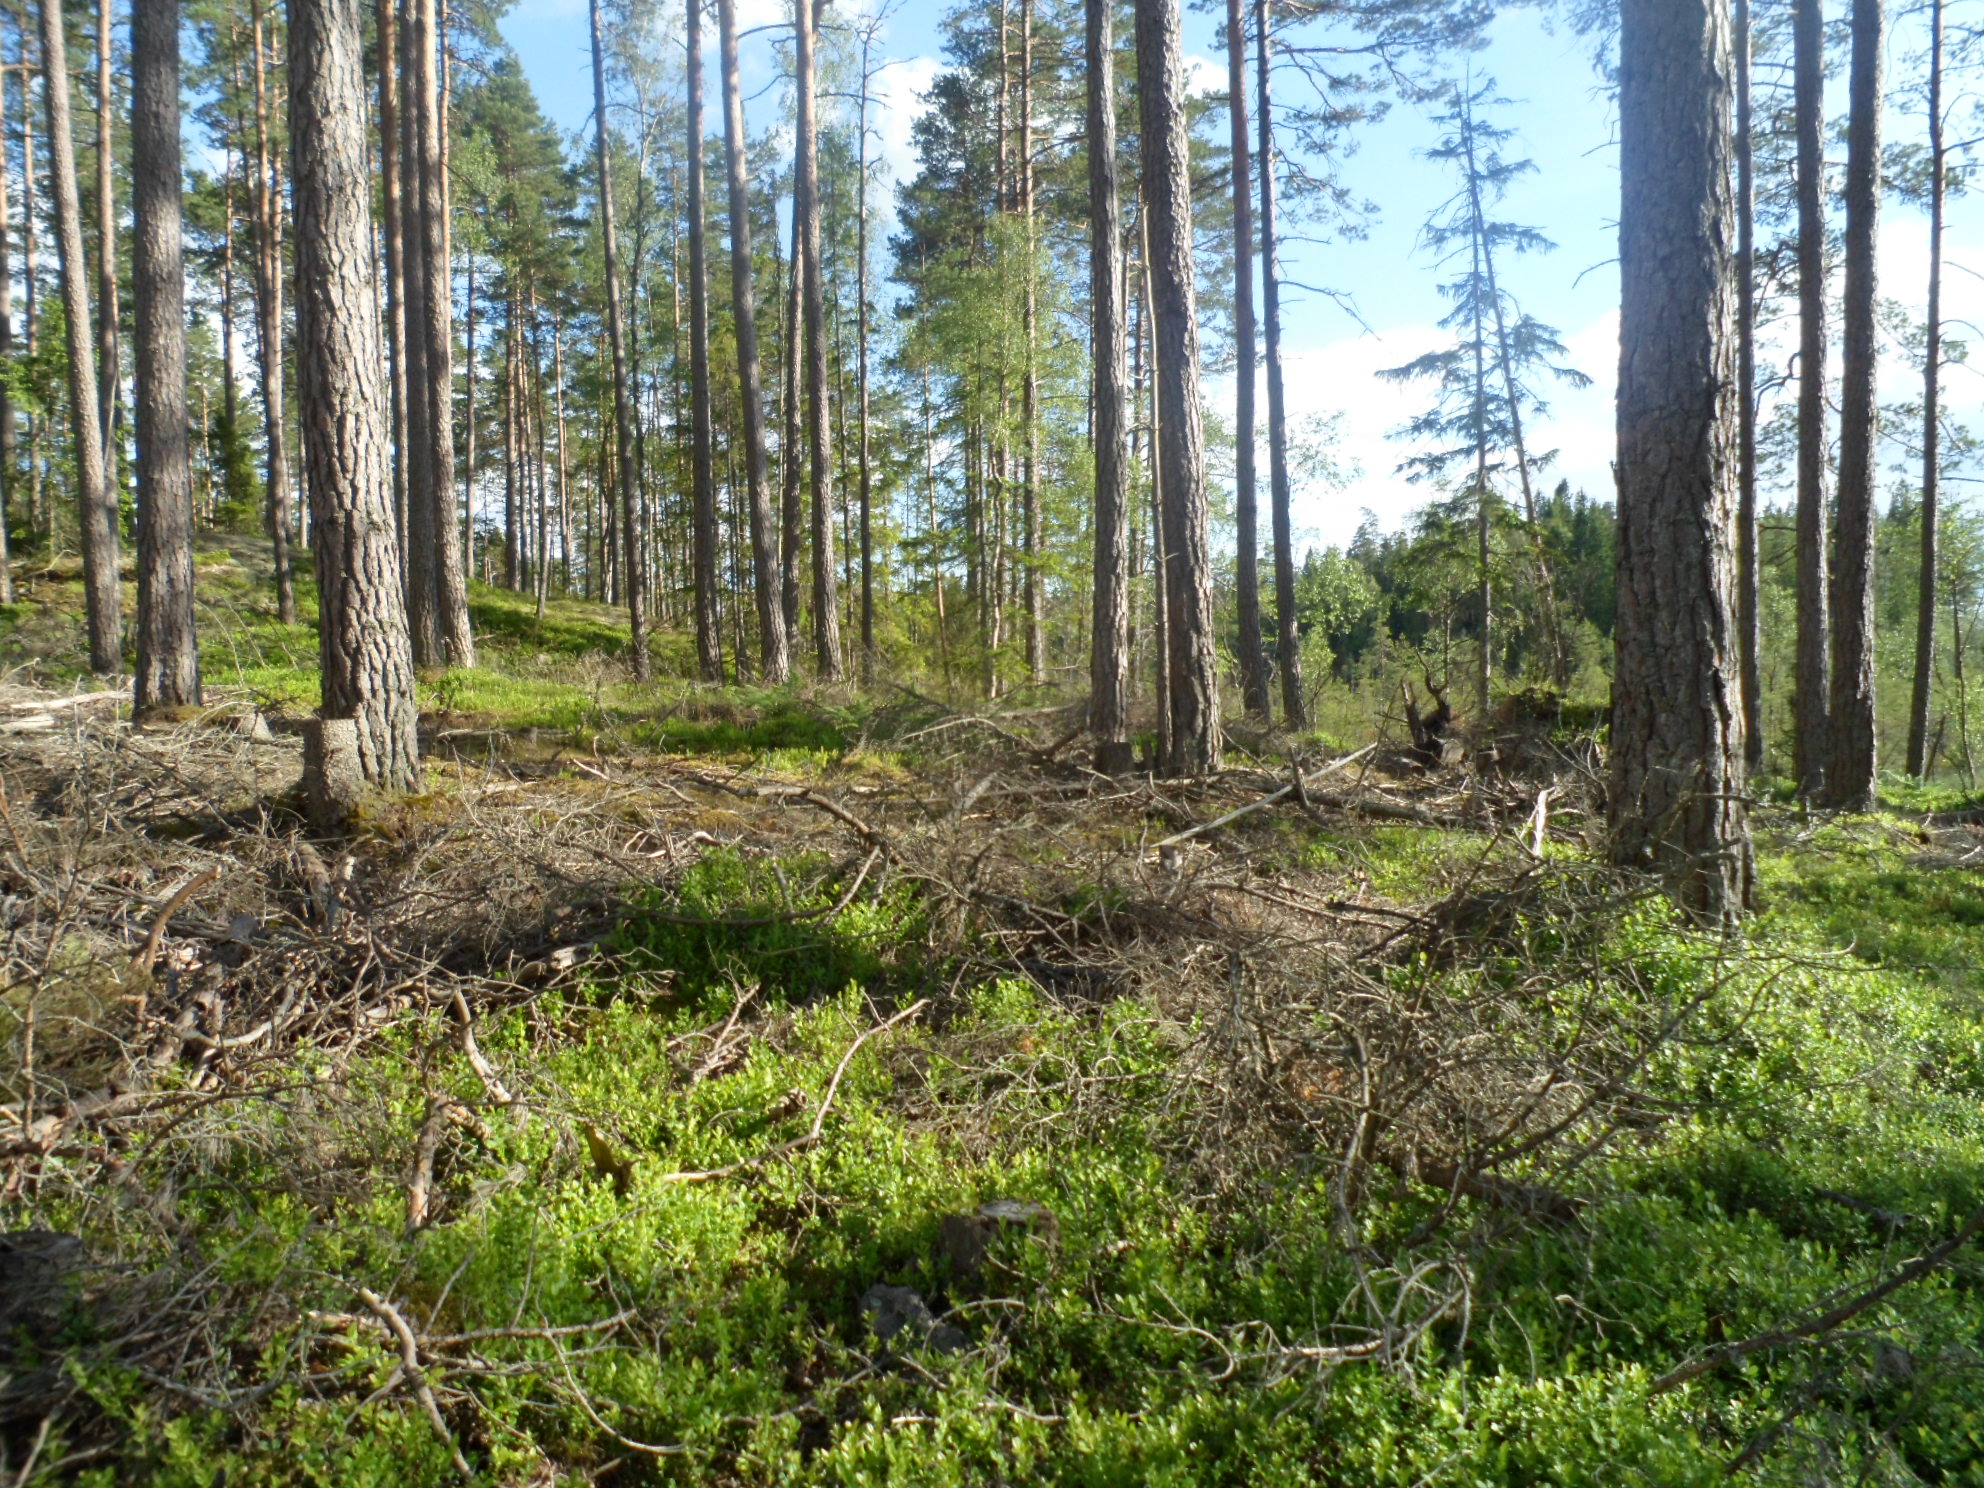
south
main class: Woodland
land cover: Pine dominated coniferous woodland
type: boreal forest
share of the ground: 25 - 50 %
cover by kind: coniferous forest trees 35 %, shrubs 30 %, herbaceous plants 10 %, lichens and mosses 10 %, unconsolidated bare surface 10 %, broadleaved forest trees 5 %
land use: Forestry
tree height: > 5 m
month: June
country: SE
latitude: 57.2024
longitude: 14.6477
